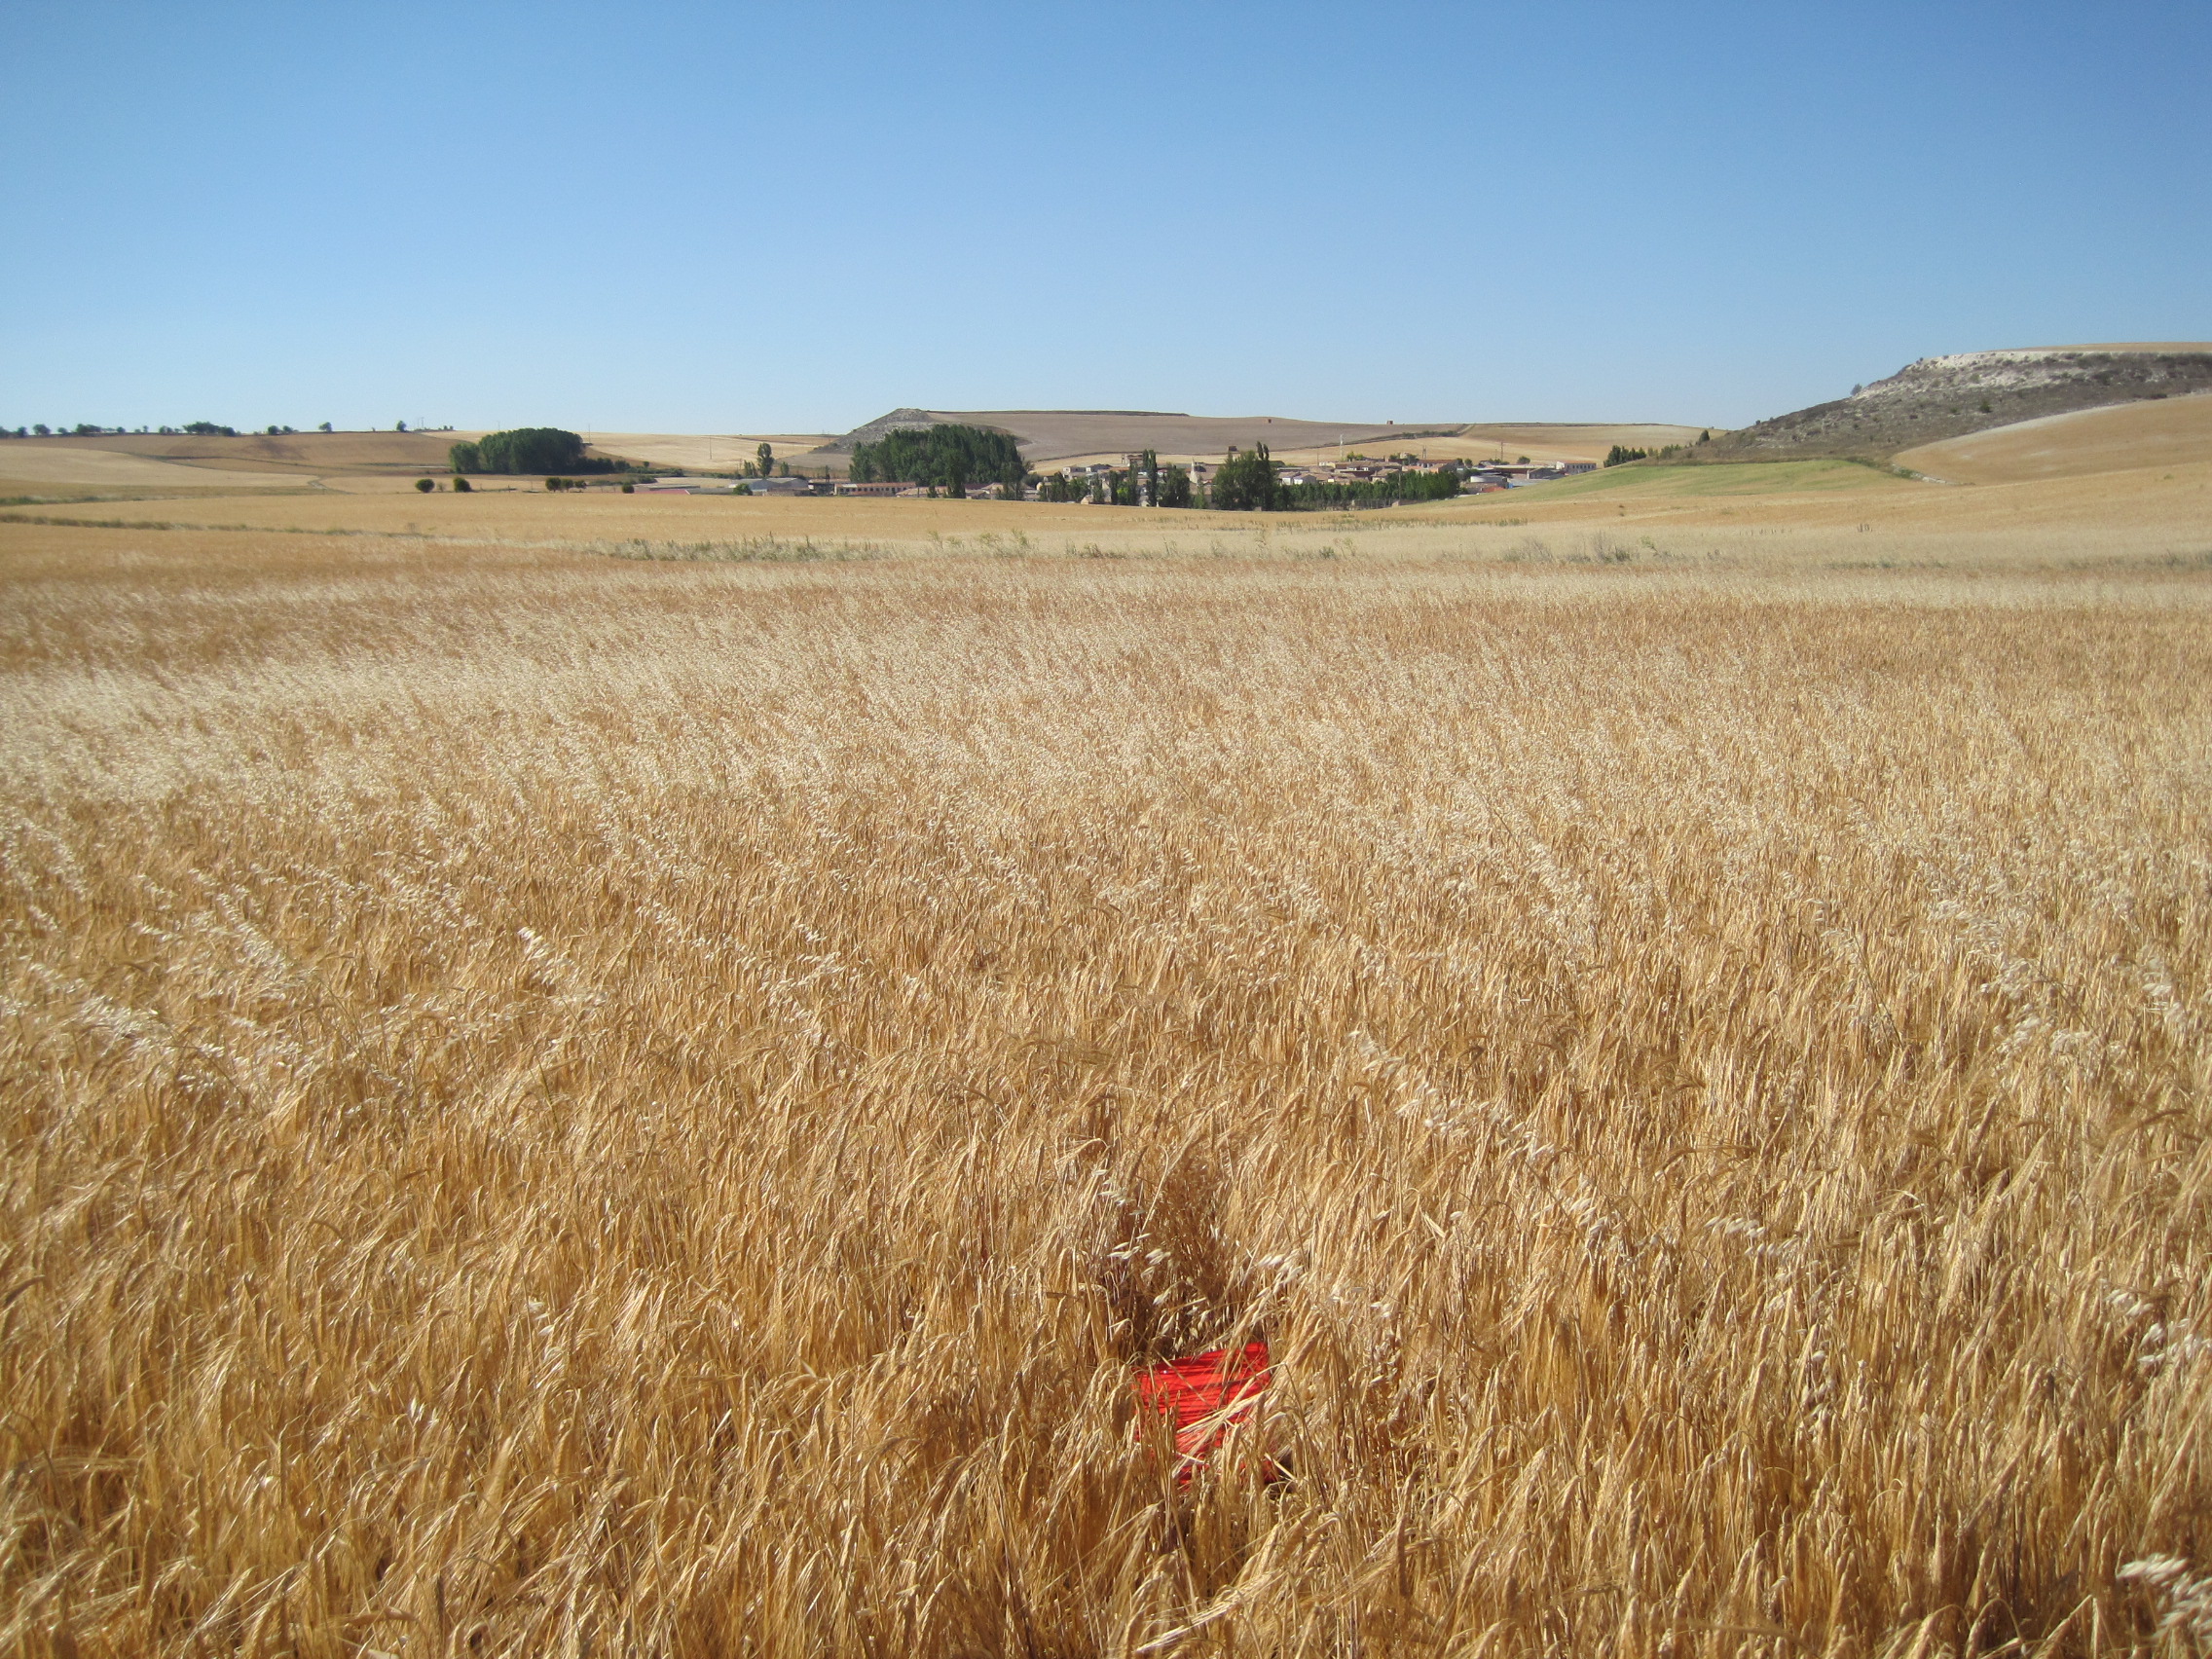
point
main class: Cropland
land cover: Barley
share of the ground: > 75 %
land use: Agriculture (excluding fallow land and kitchen gardens)
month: June
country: ES
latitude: 41.6400
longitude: -5.1188
